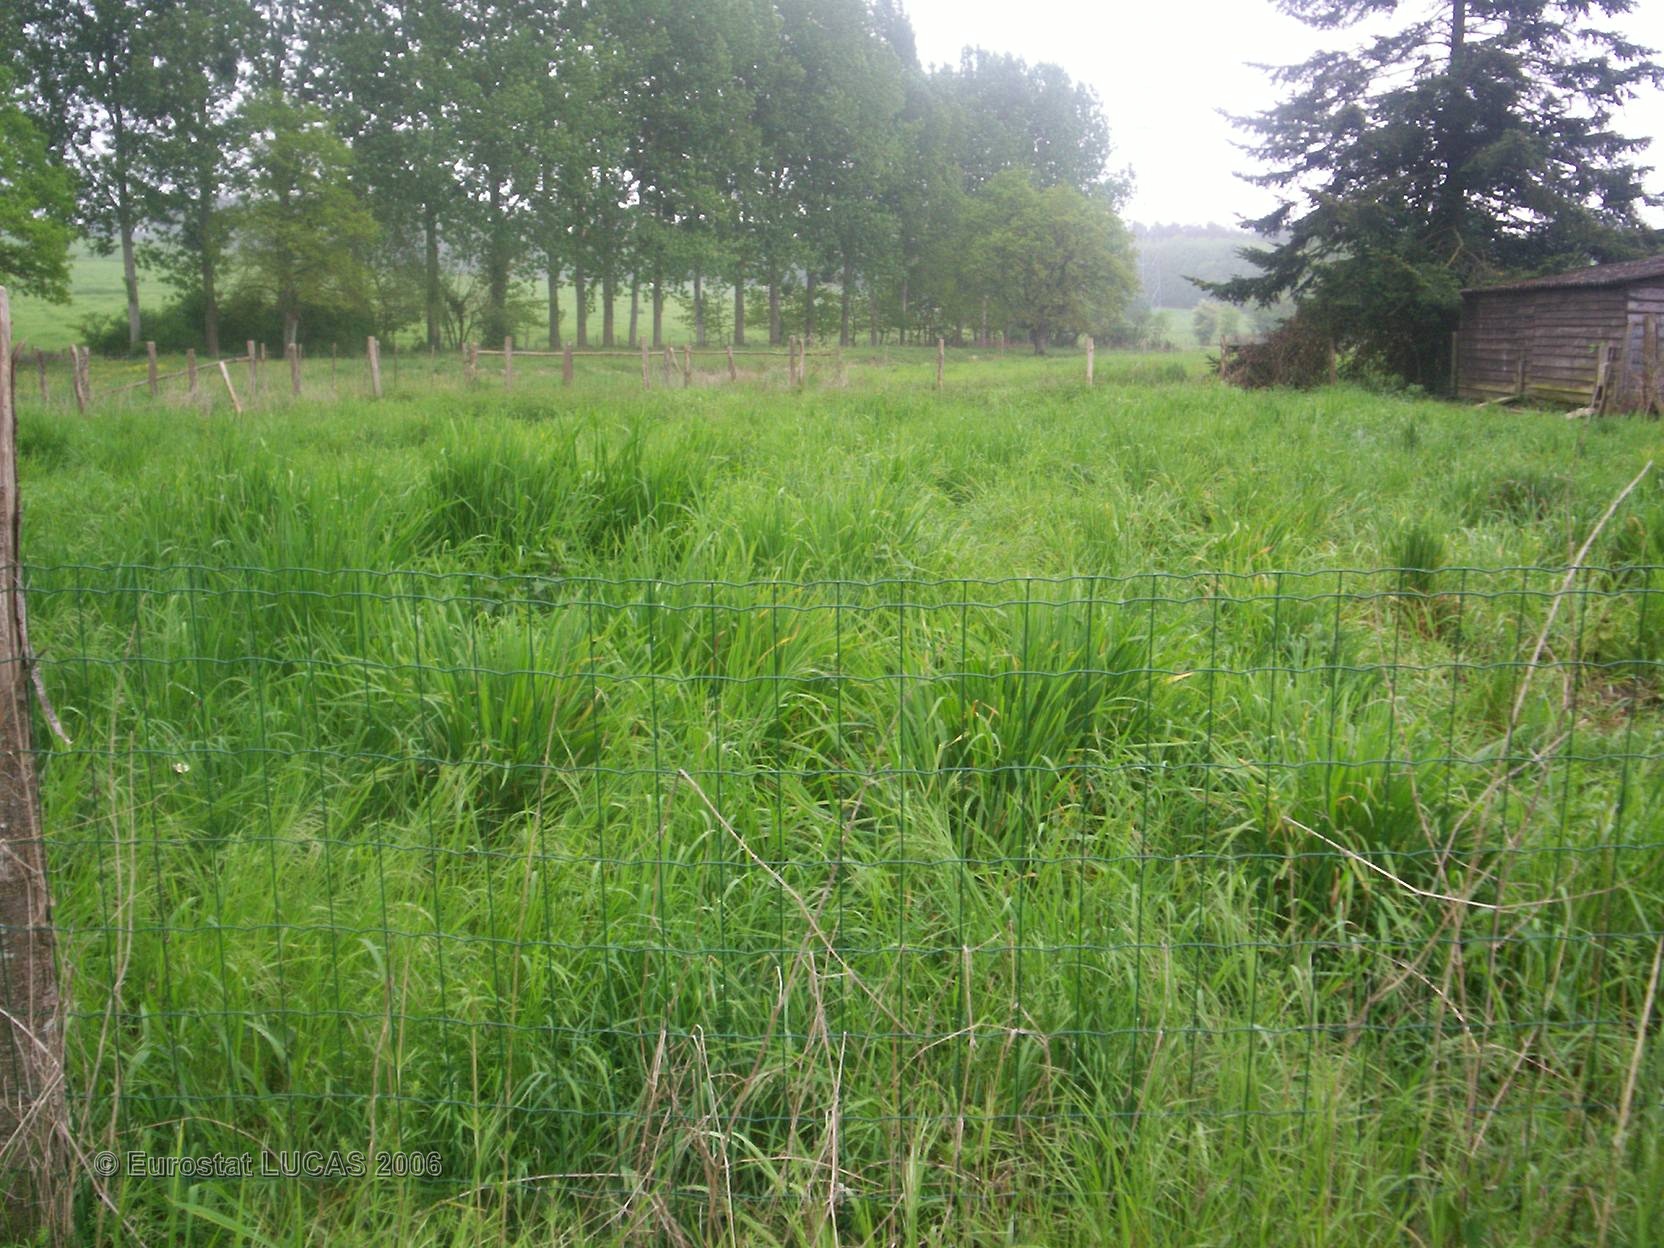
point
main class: Grassland
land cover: Grassland without tree/shrub cover
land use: Agriculture (excluding fallow land and kitchen gardens)
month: May
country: FR
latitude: 47.9132
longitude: 0.4093
